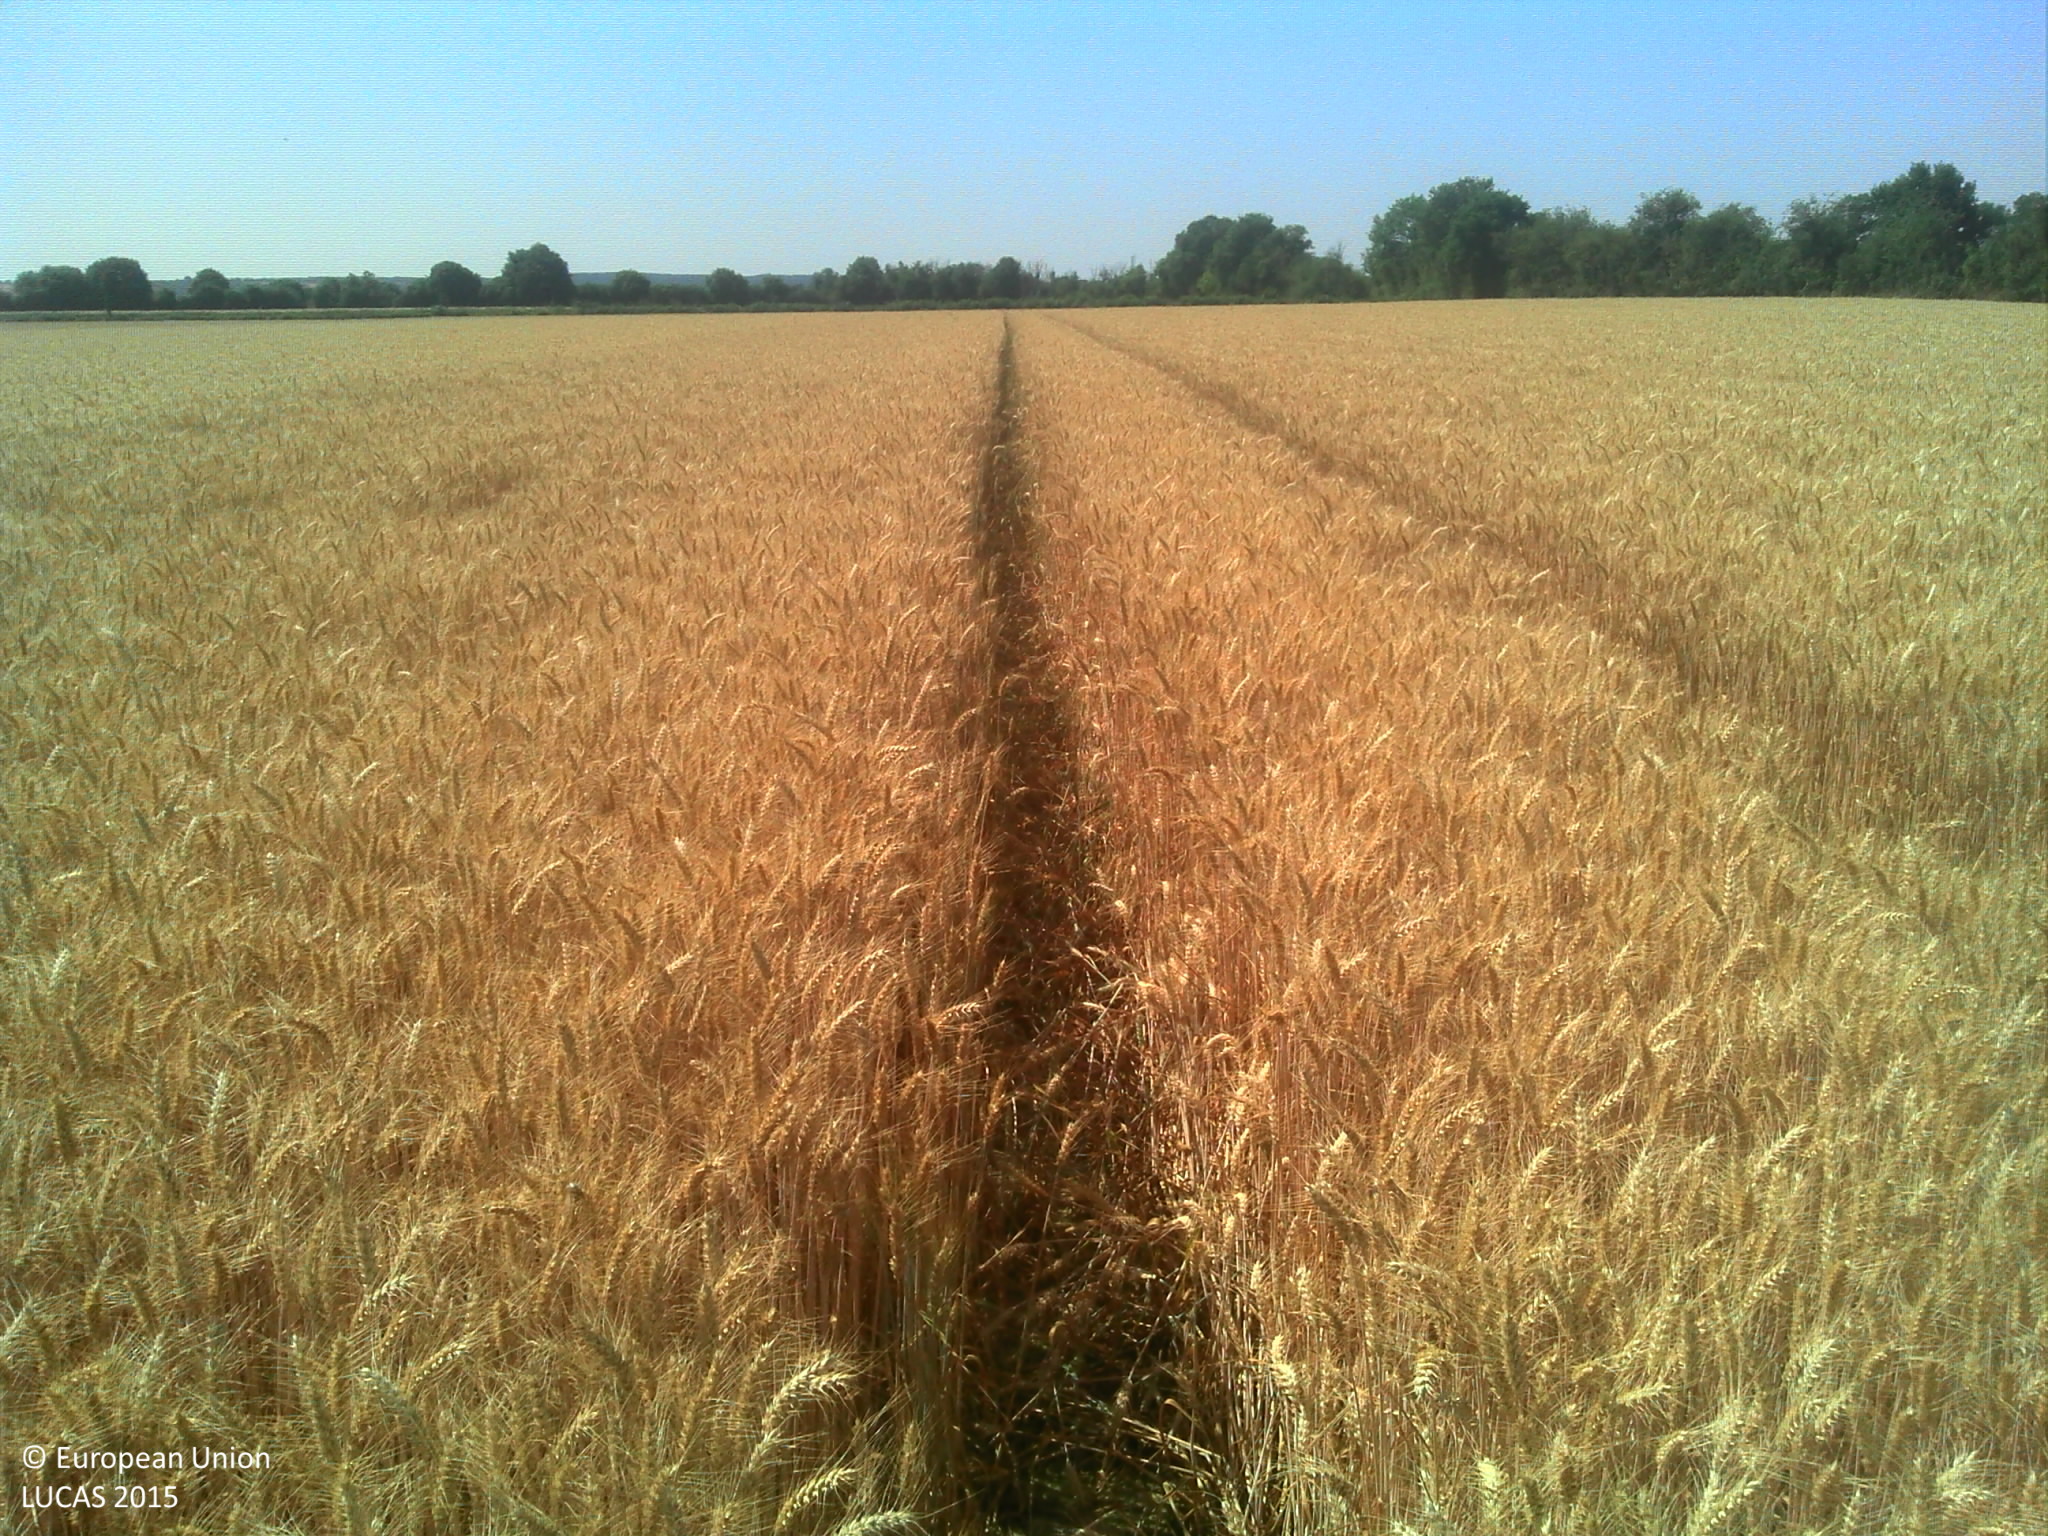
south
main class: Cropland
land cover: Durum wheat
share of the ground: > 75 %
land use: Agriculture (excluding fallow land and kitchen gardens)
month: July
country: FR
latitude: 47.9898
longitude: 0.8814
